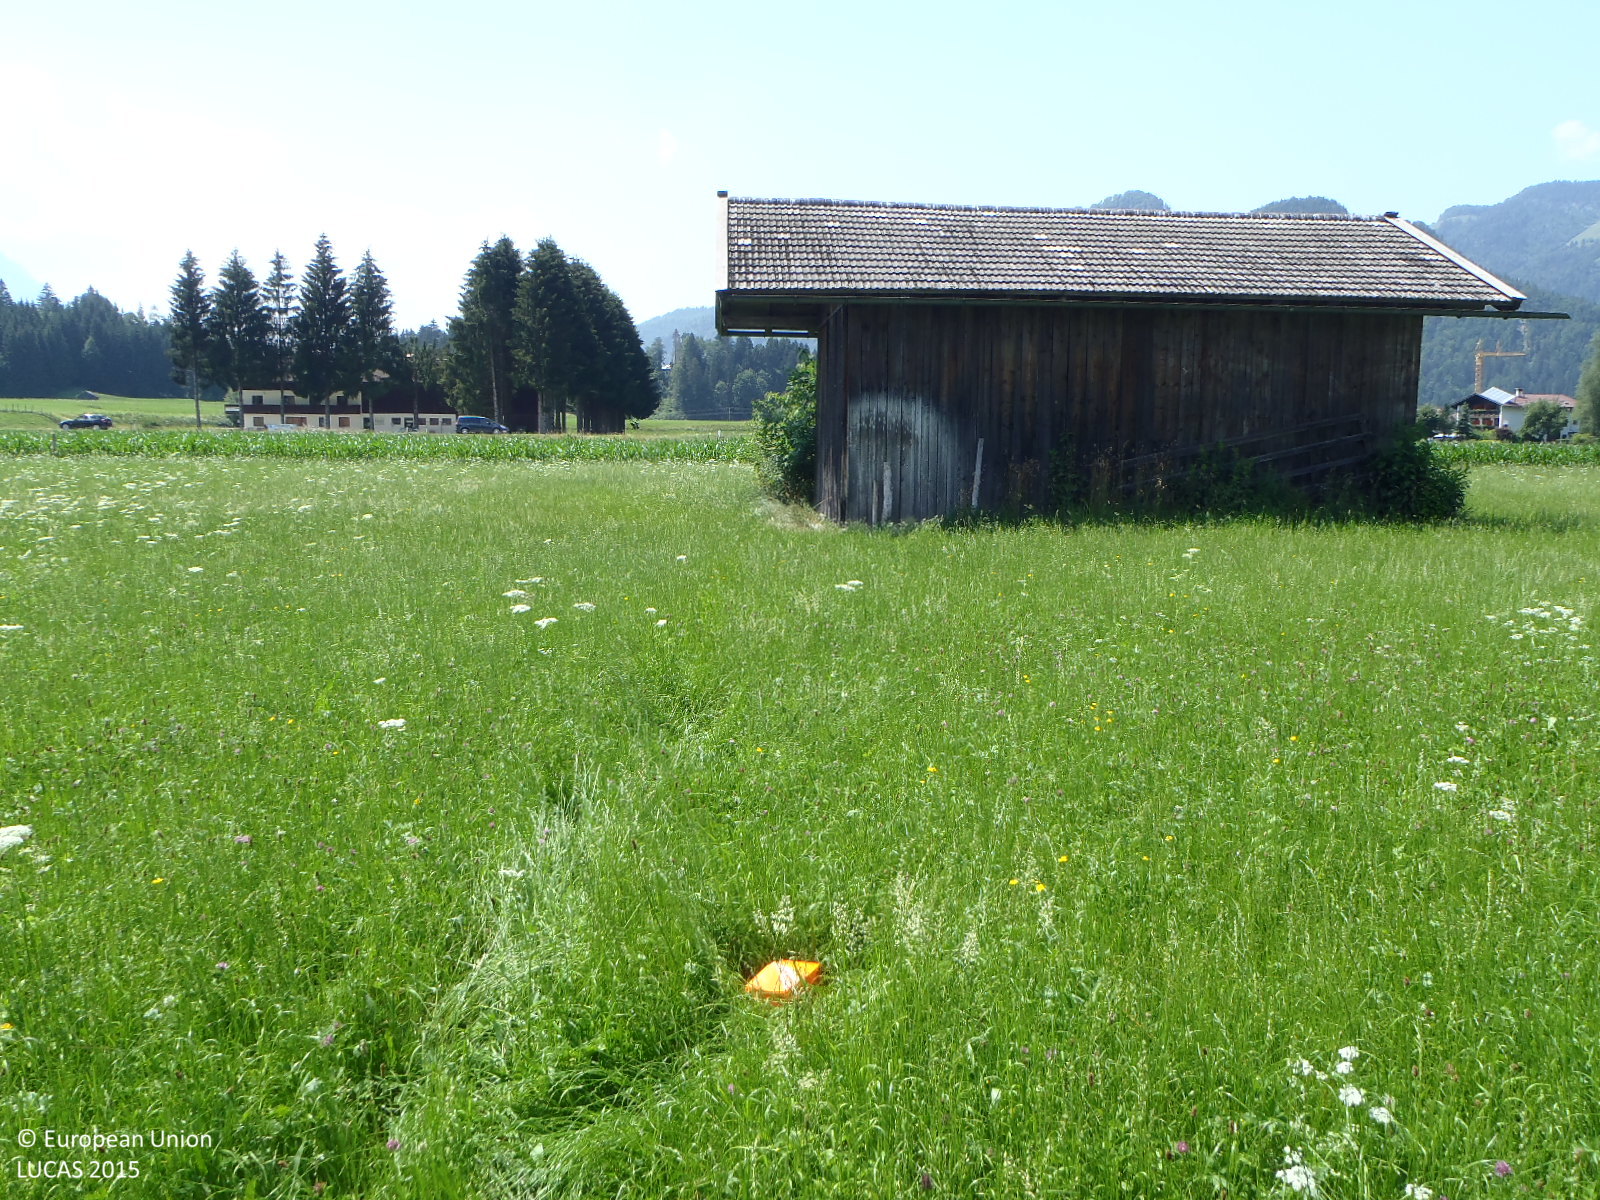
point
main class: Grassland
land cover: Grassland without tree/shrub cover
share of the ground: > 75 %
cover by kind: herbaceous plants 100 %
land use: Agriculture (excluding fallow land and kitchen gardens)
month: July
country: AT
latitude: 47.6571
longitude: 12.4085
